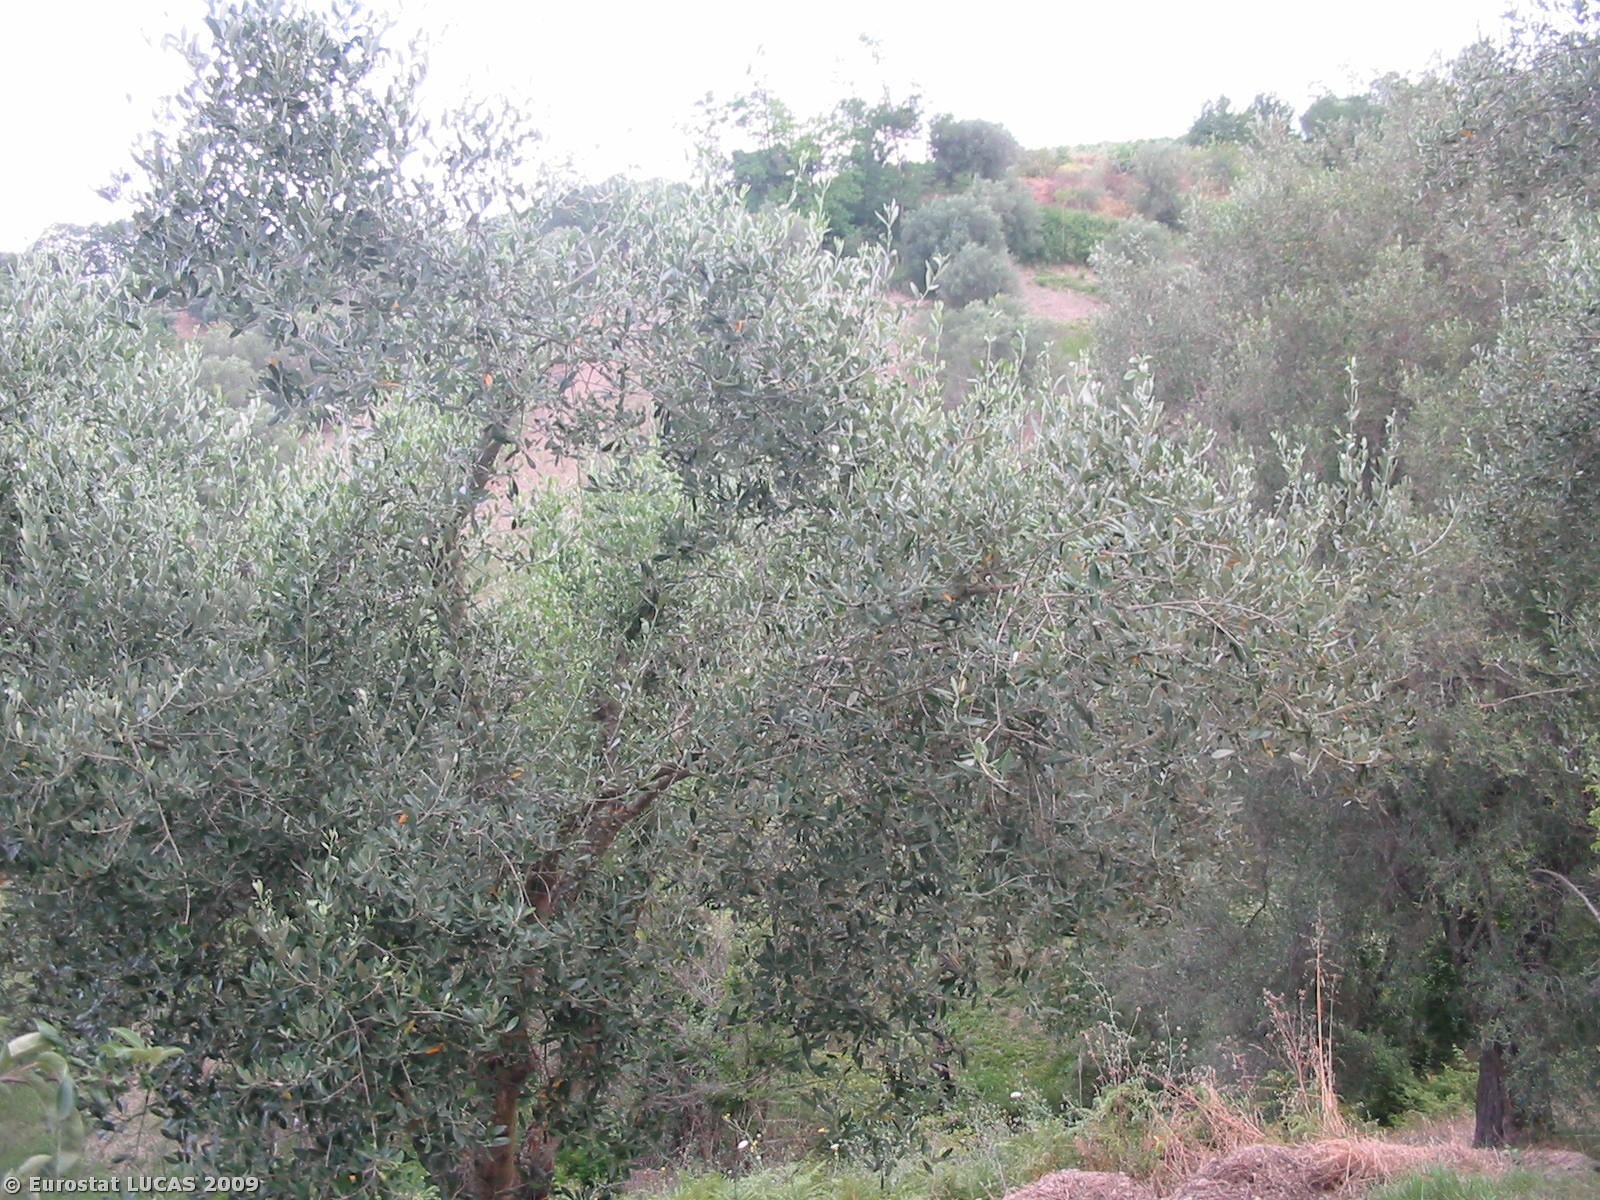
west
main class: Shrubland
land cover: Shrubland with sparse tree cover
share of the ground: > 75 %
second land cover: Olive groves
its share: 25 - 50 %
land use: Fallow land
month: July
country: IT
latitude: 38.6073
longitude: 16.0862
